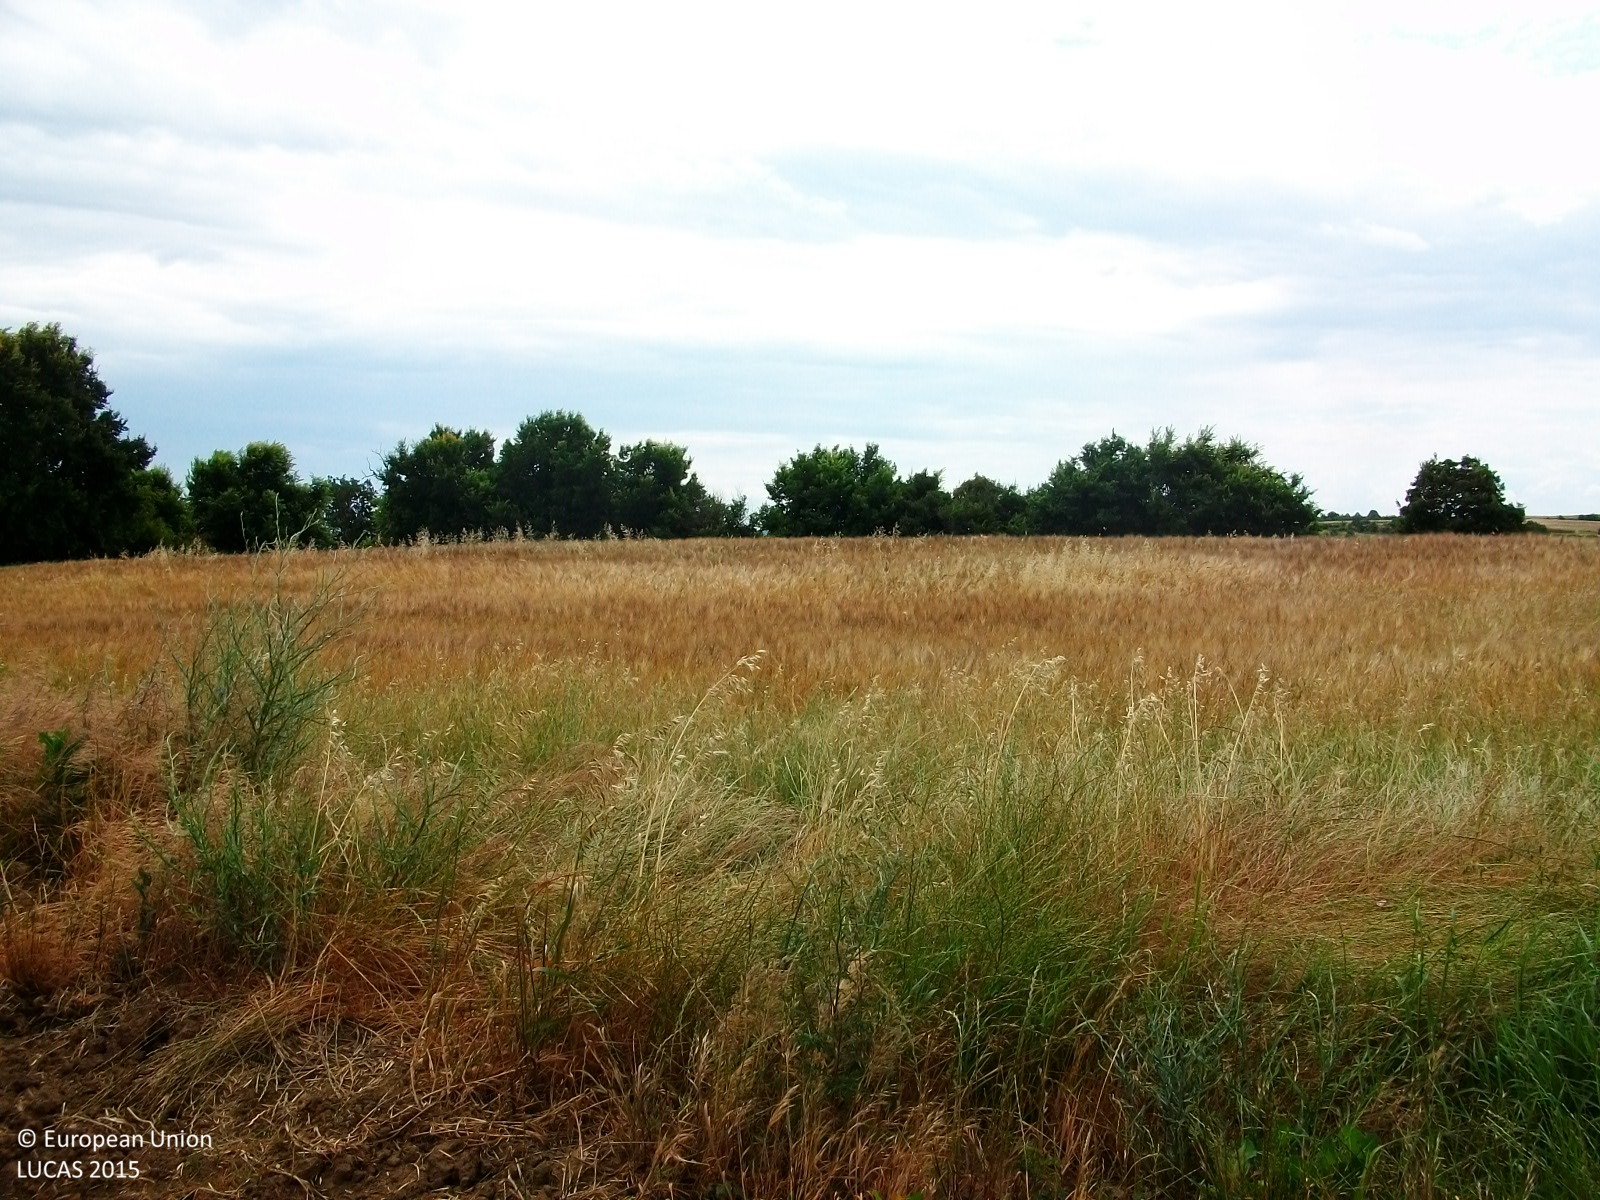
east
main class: Cropland
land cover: Sunflower
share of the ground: 10 - 25 %
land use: Agriculture (excluding fallow land and kitchen gardens)
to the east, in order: Sunflower; Shruby margins; Common wheat; Broadleaved woodland; Shruby margins; Tracks; Grass margins; Sunflower; Broadleaved woodland; Grassland without tree/shrub cover; Broadleaved woodland
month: June
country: GR
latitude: 41.6522
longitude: 26.2004
